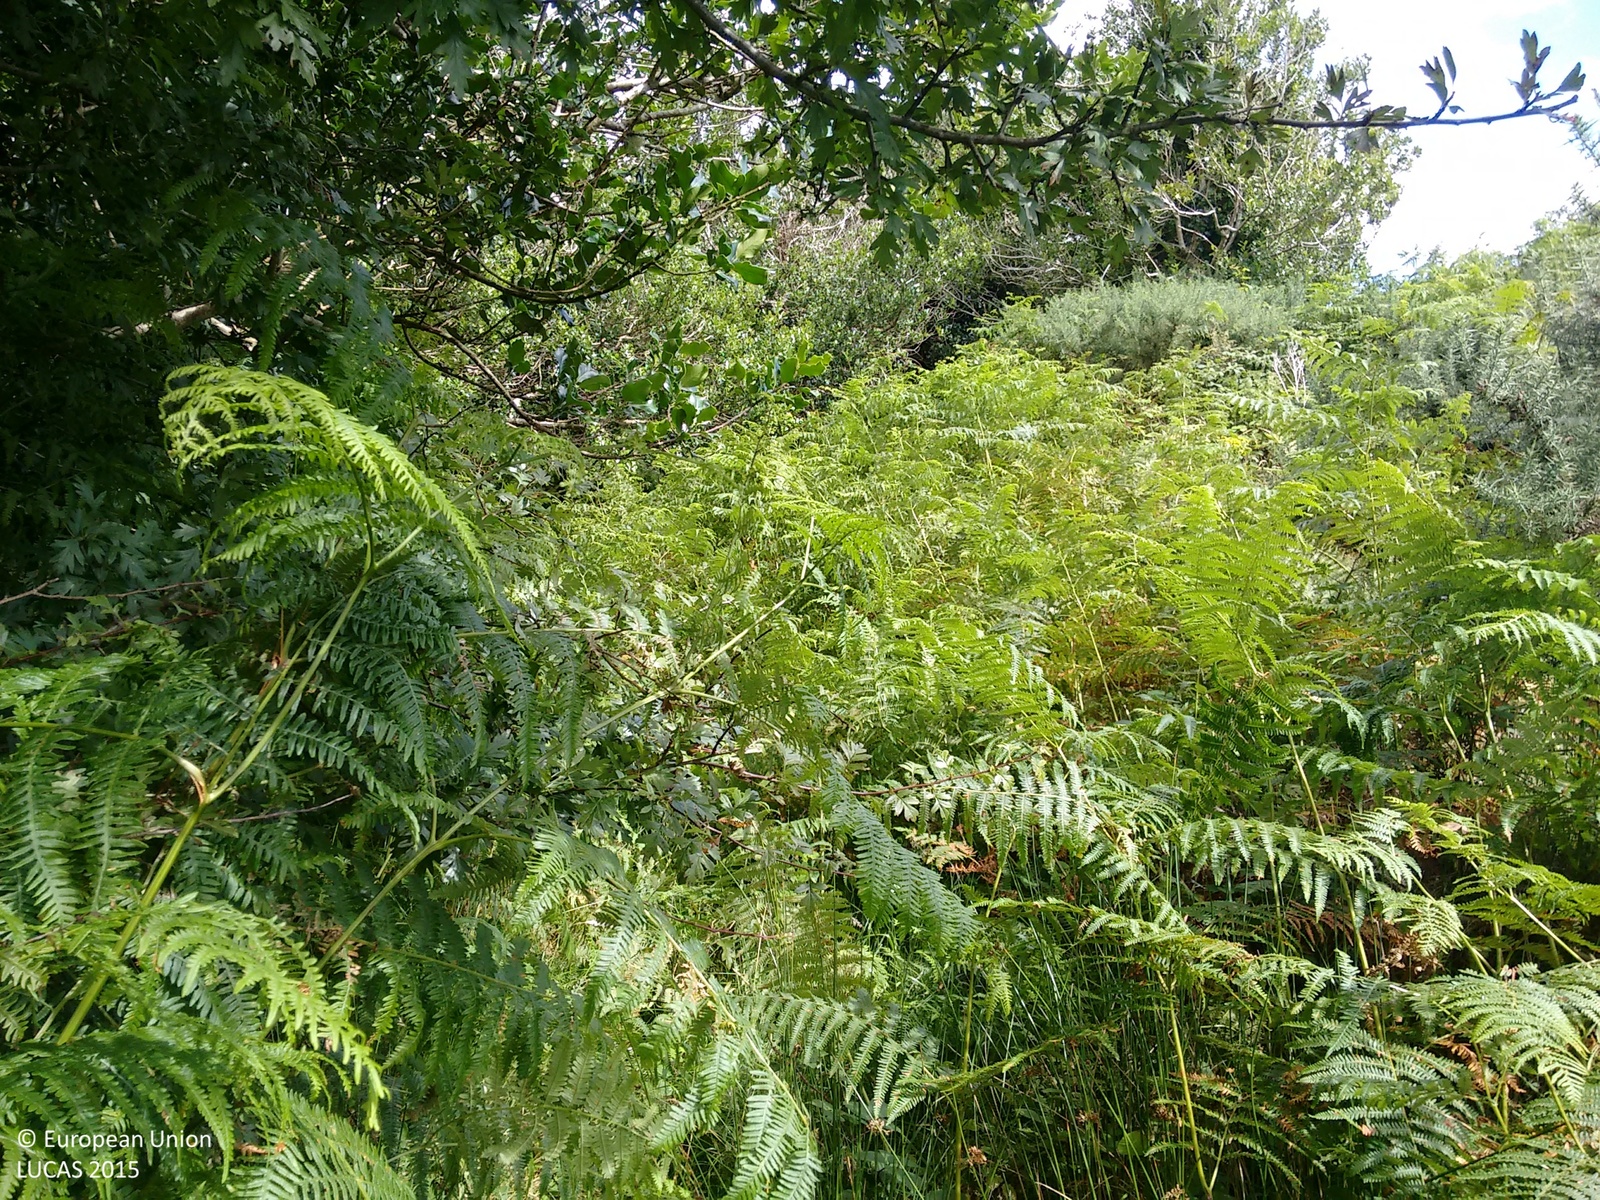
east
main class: Shrubland
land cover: Shrubland without tree cover
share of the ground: > 75 %
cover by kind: shrubs 70 %, herbaceous plants 30 %
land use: Agriculture (excluding fallow land and kitchen gardens)
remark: Harvested field
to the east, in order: Shrubland without tree cover; Abandoned hedges; Shrubland with sparse tree cover; Broadleaved woodland; Grassland without tree/shrub cover; Shrubland without tree cover; Tracks; Shrubland without tree cover; Artificial constructions in urban areas; Grass margins; Abandoned hedges; Shrubland with sparse tree cover
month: August
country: IE
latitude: 51.7281
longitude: -9.4429
